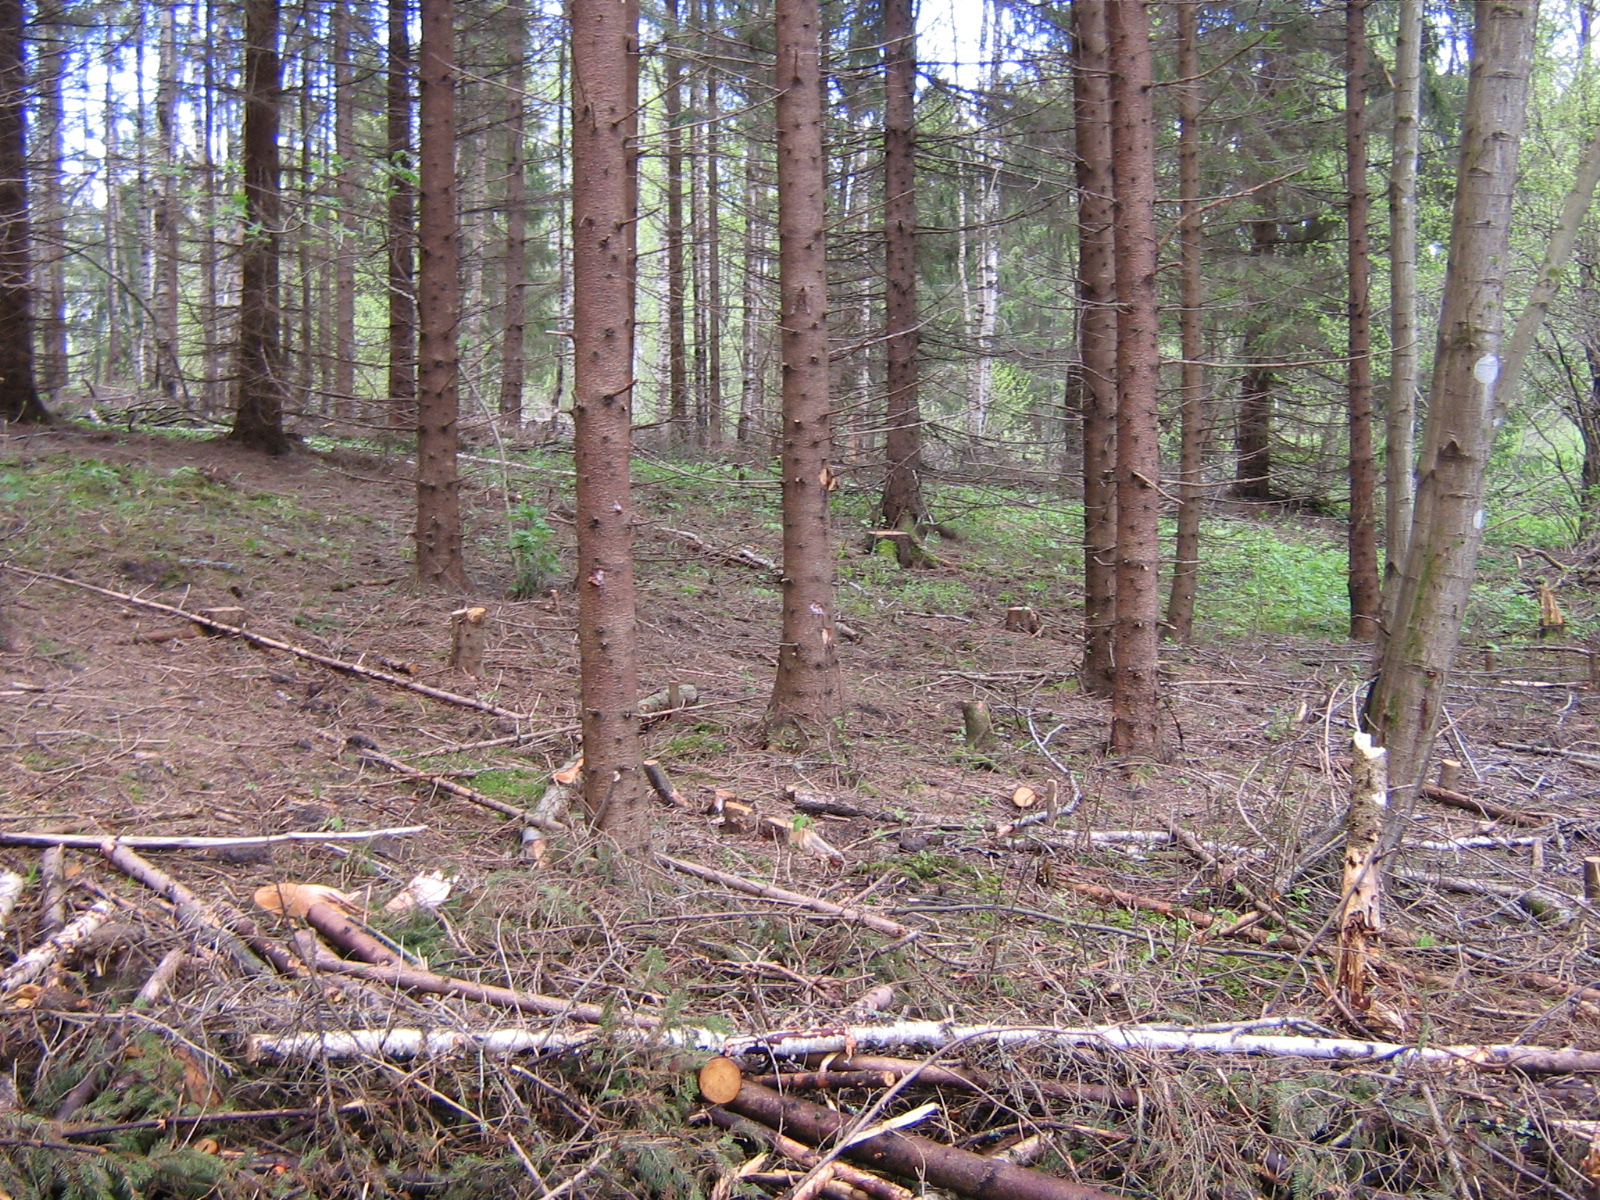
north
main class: Woodland
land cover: Spruce dominated mixed woodland
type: hemiboreal forest and nemoral coniferous forest and mixed broadleaved-coniferous forest
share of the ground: > 75 %
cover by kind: coniferous forest trees 70 %, broadleaved forest trees 30 %
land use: Forestry
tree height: > 5 m
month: May
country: LV
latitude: 57.1811
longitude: 25.5190
